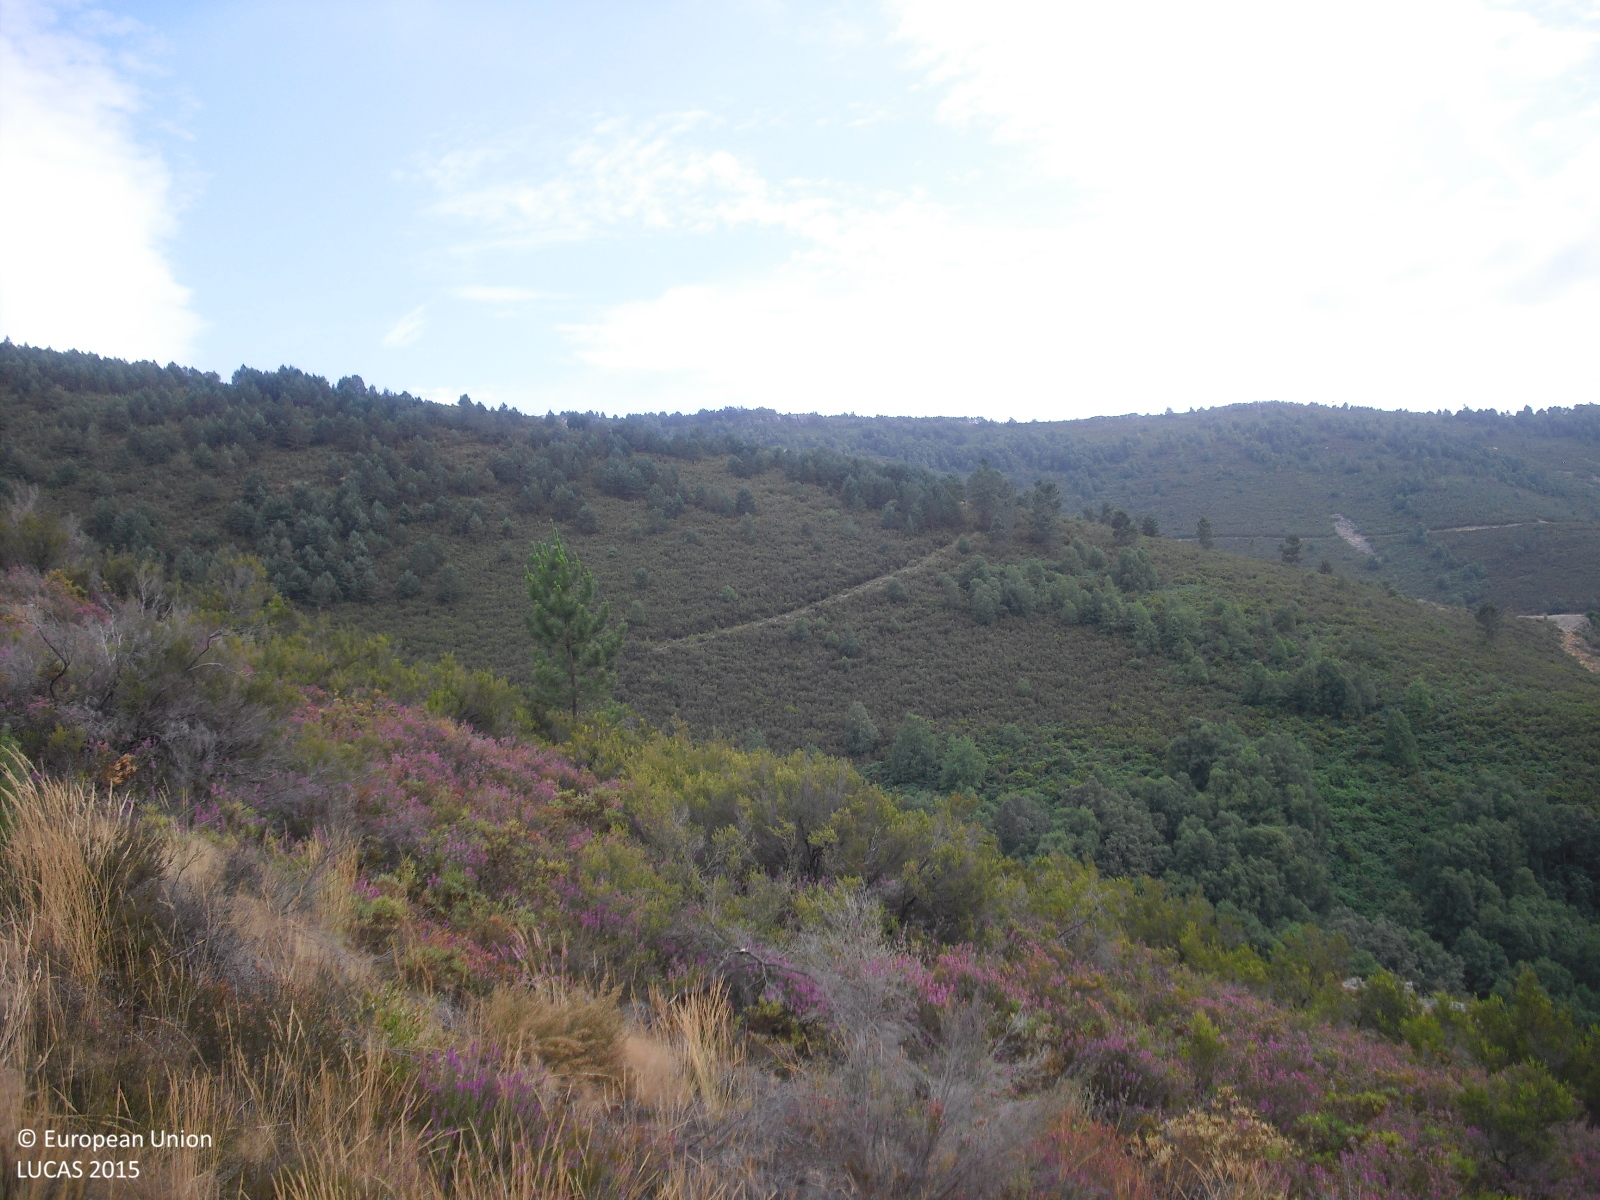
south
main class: Woodland
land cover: Pine dominated mixed woodland
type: hemiboreal forest and nemoral coniferous forest and mixed broadleaved-coniferous forest
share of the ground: 25 - 50 %
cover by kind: broadleaved forest trees 50 %, coniferous forest trees 30 %, consolidated bare surface 20 %
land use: Semi-natural and natural areas not in use
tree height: > 5 m
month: July
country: ES
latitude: 42.5435
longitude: -7.2446
